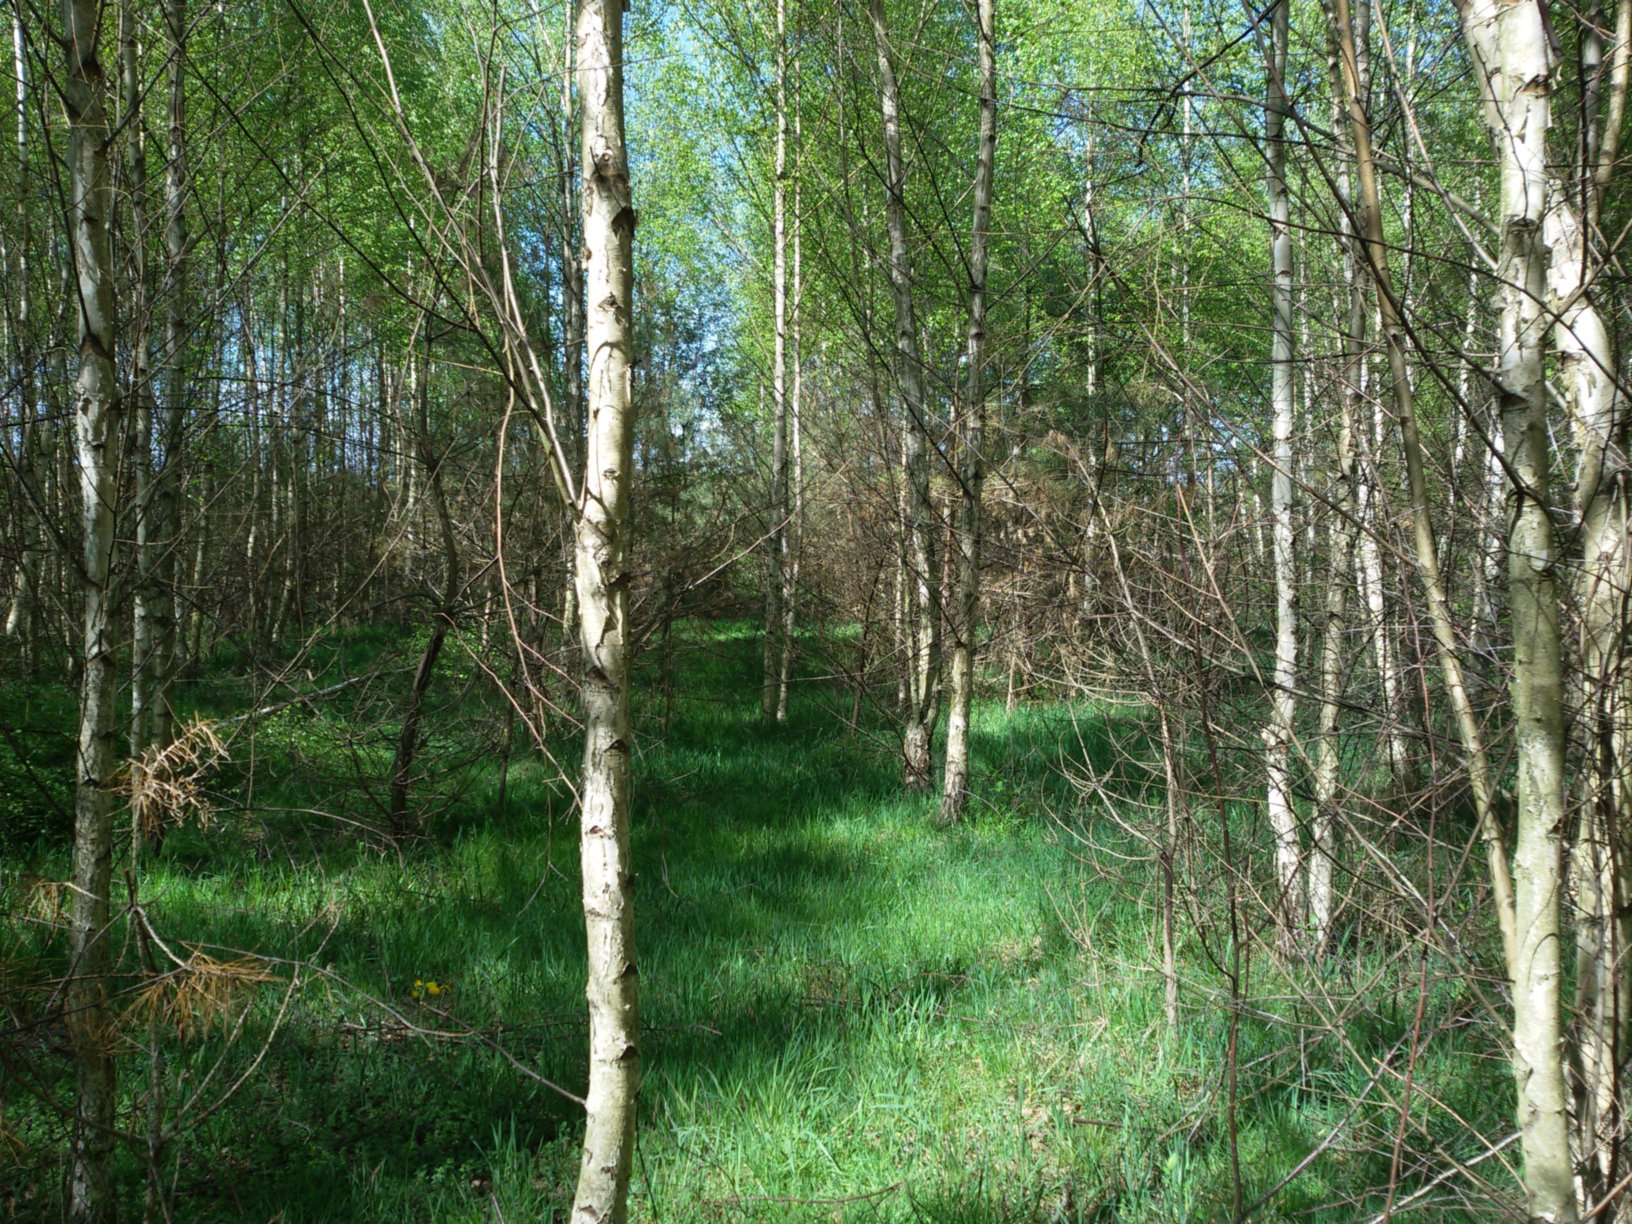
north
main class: Woodland
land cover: Broadleaved woodland
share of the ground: > 75 %
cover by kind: broadleaved forest trees 80 %, lichens and mosses 20 %
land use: Forestry
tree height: > 5 m
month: April
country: PL
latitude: 51.5170
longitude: 15.7549
